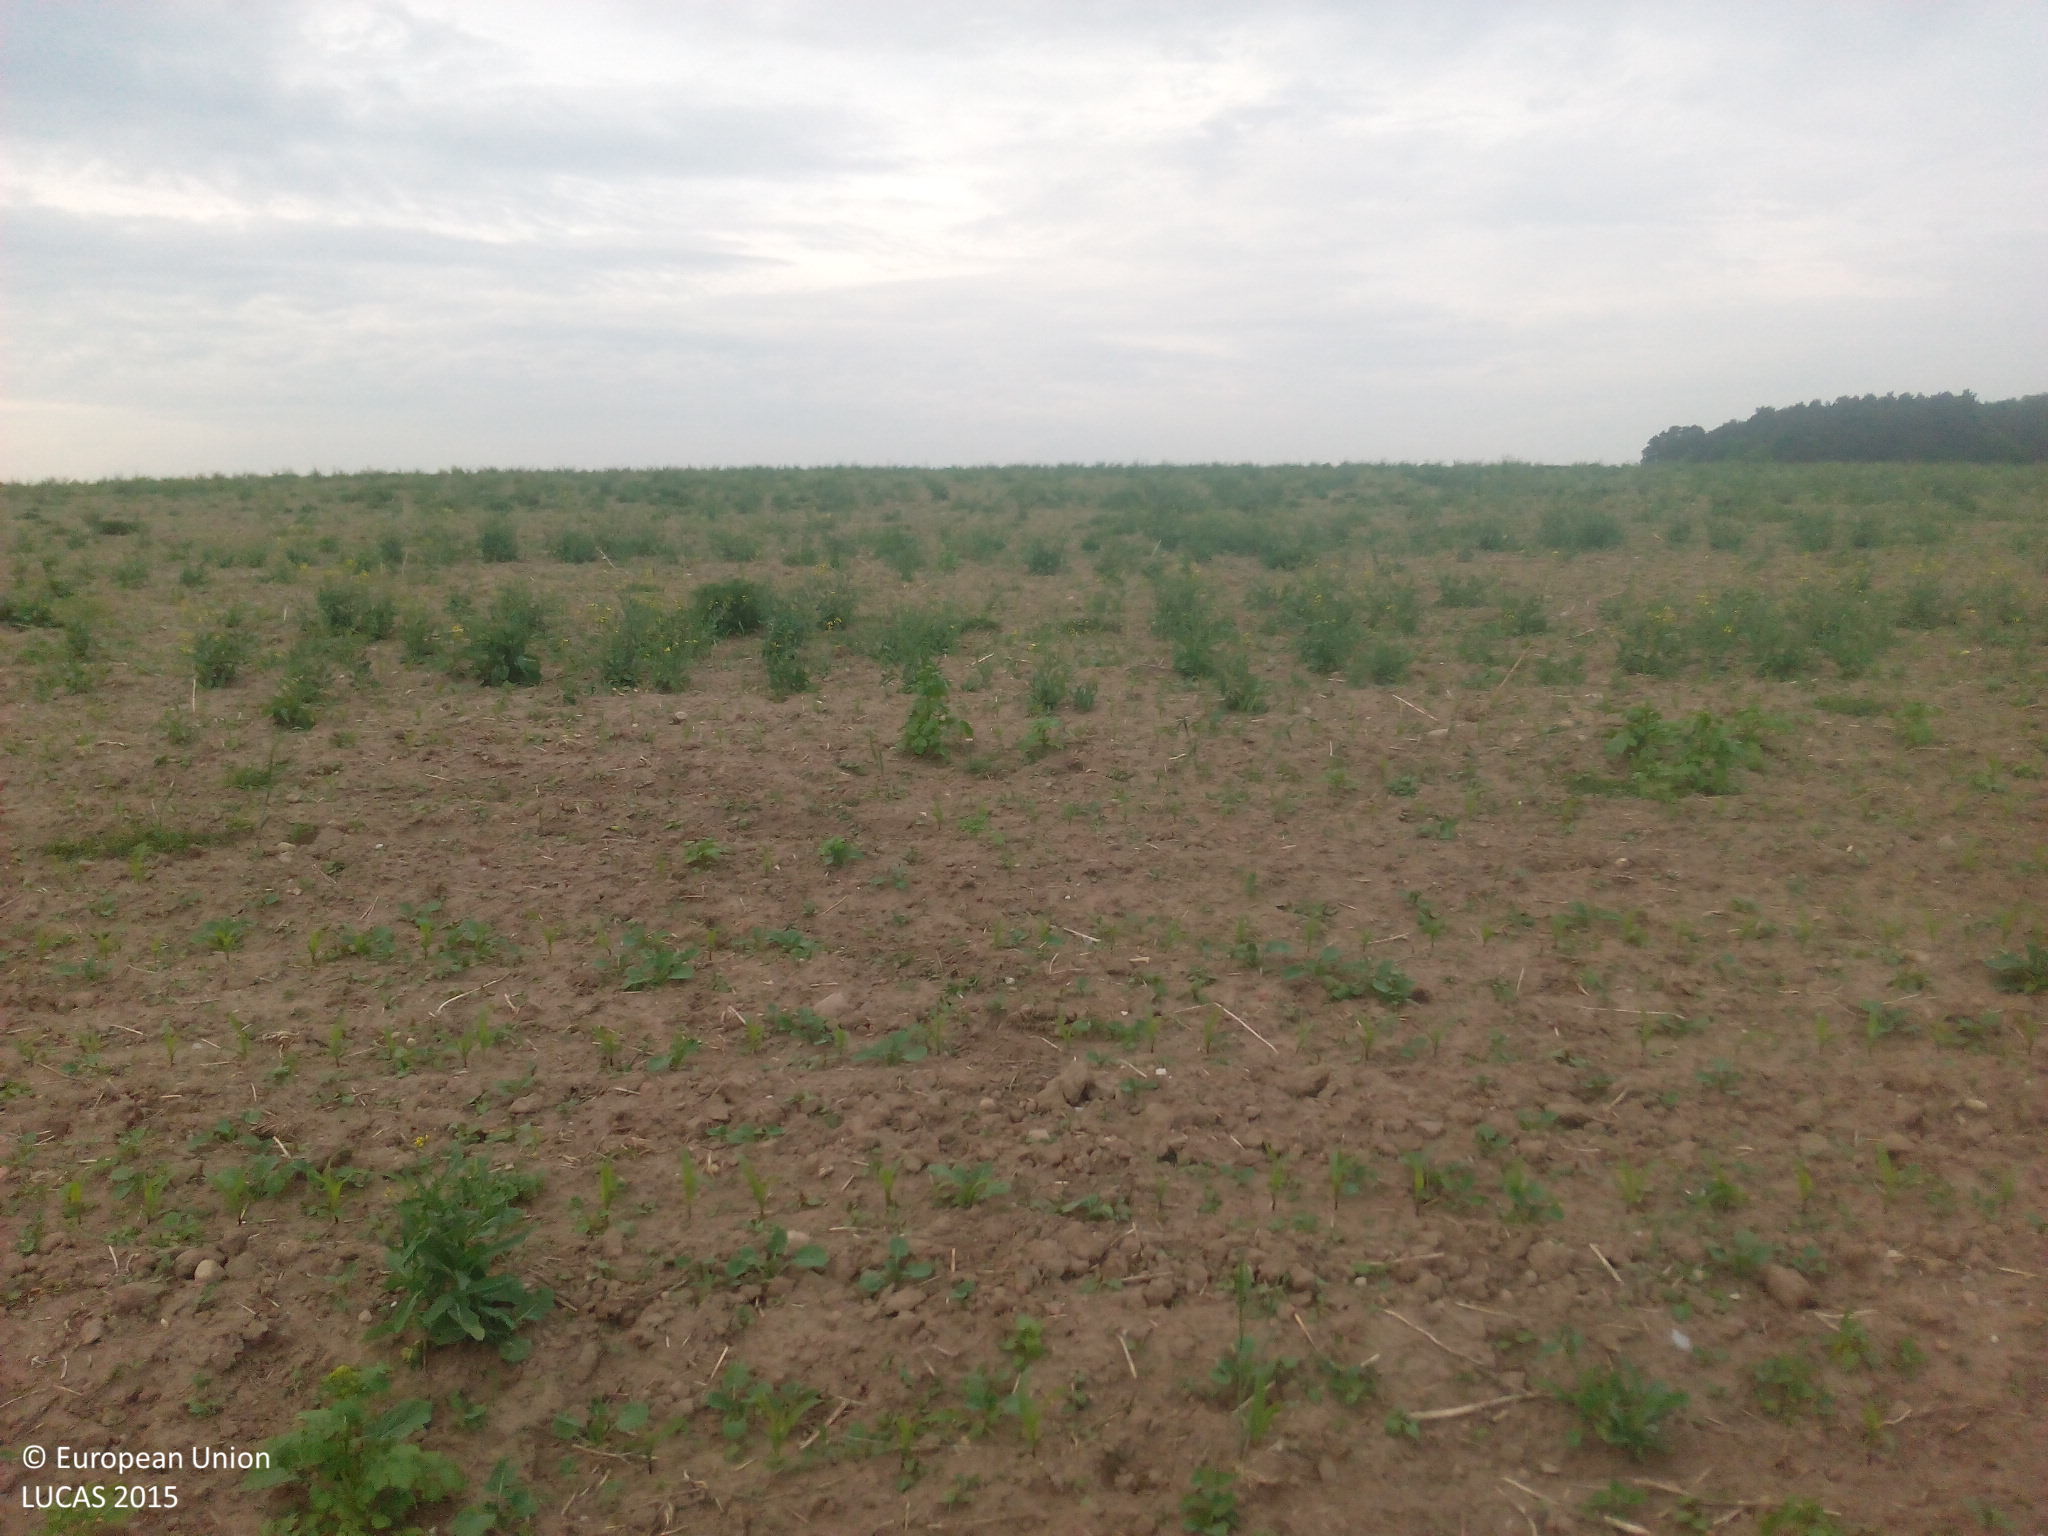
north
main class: Cropland
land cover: Maize
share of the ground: < 10 %
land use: Agriculture (excluding fallow land and kitchen gardens)
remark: Tilled/Sowed
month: May
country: DE
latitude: 52.2302
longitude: 13.0599
